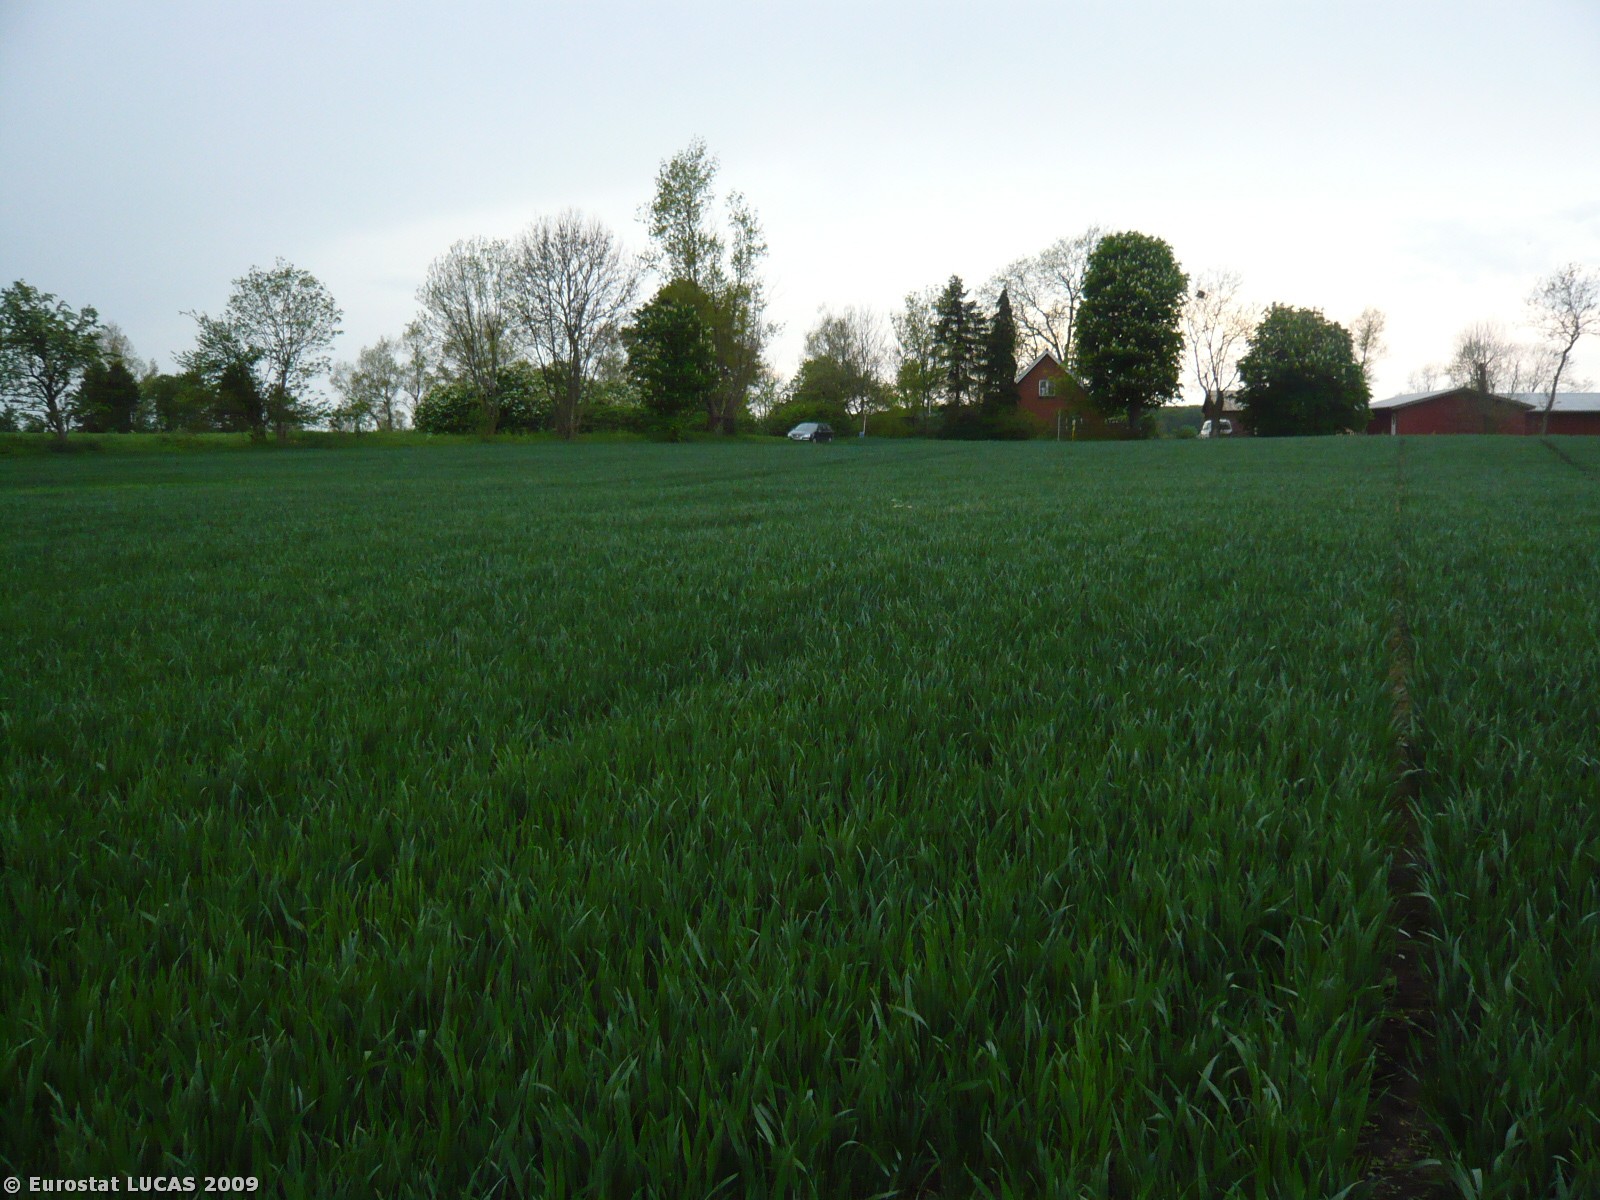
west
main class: Cropland
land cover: Common wheat
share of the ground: > 75 %
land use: Agriculture (excluding fallow land and kitchen gardens)
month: May
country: DK
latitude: 55.3990
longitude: 12.0038
